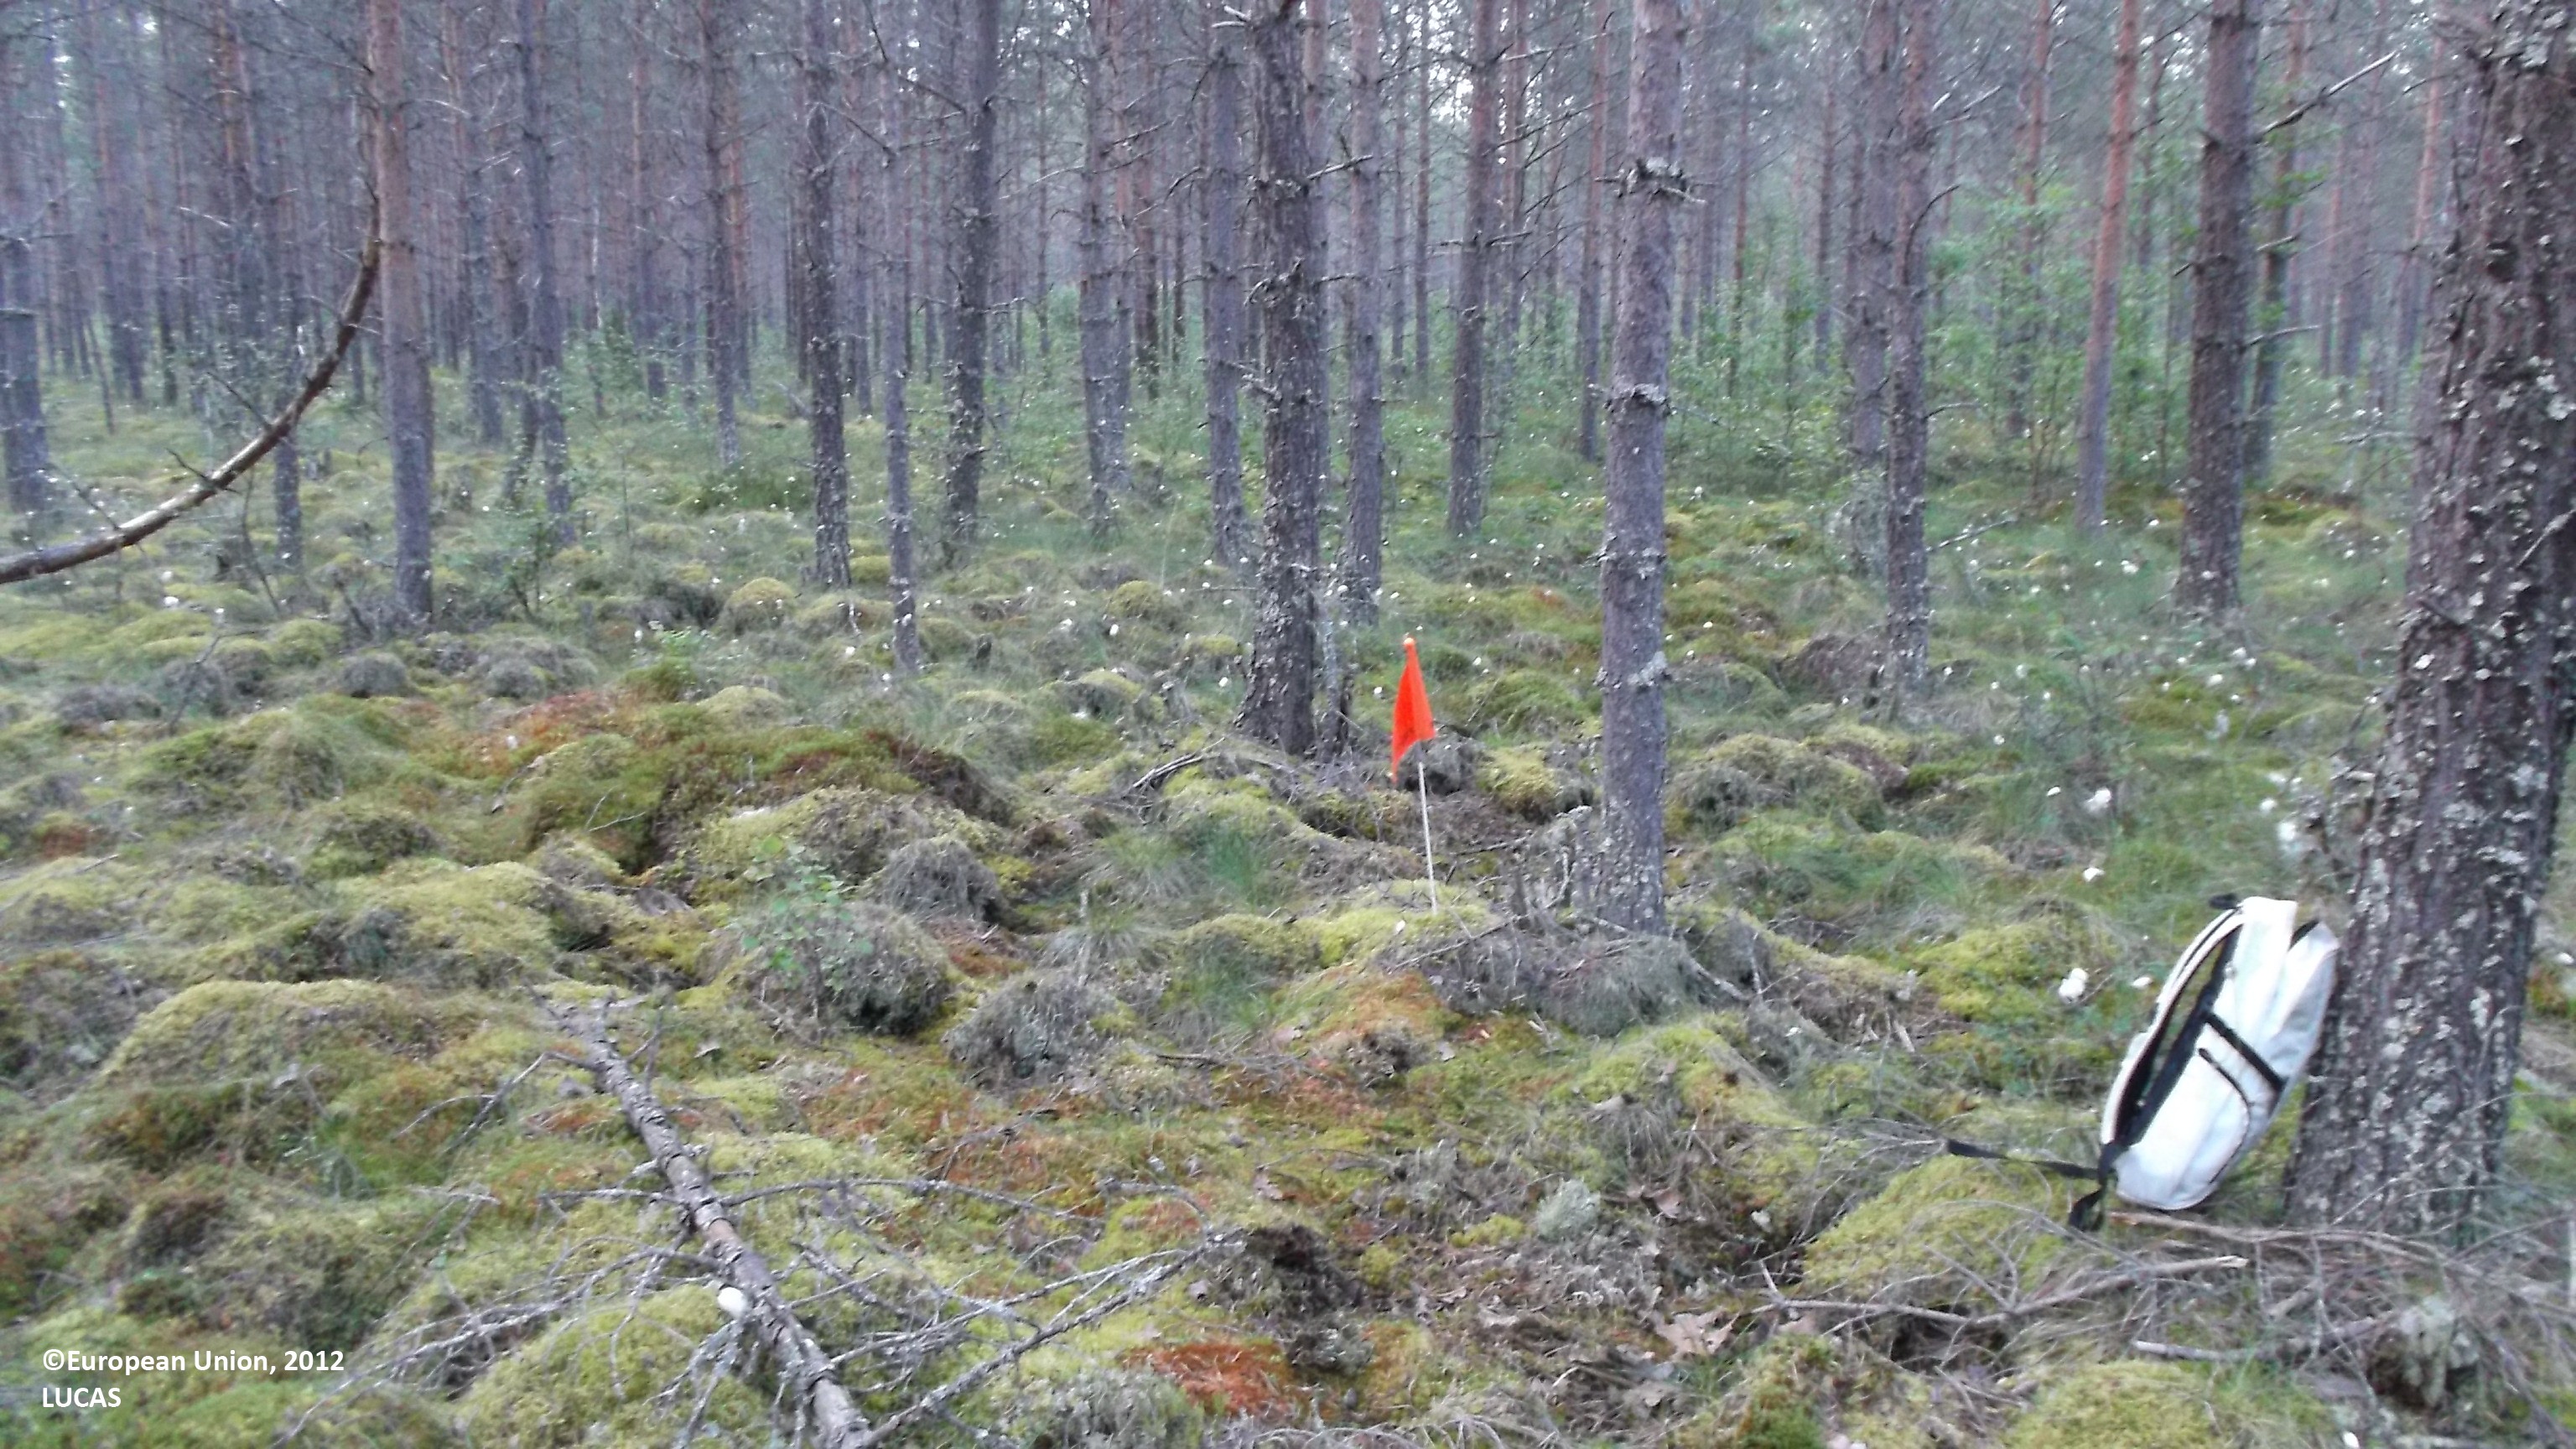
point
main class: Woodland
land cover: Pine dominated coniferous woodland
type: mire and swamp forests
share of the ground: 25 - 50 %
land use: Semi-natural and natural areas not in use
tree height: > 5 m
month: July
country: FI
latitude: 63.3632
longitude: 24.4549
